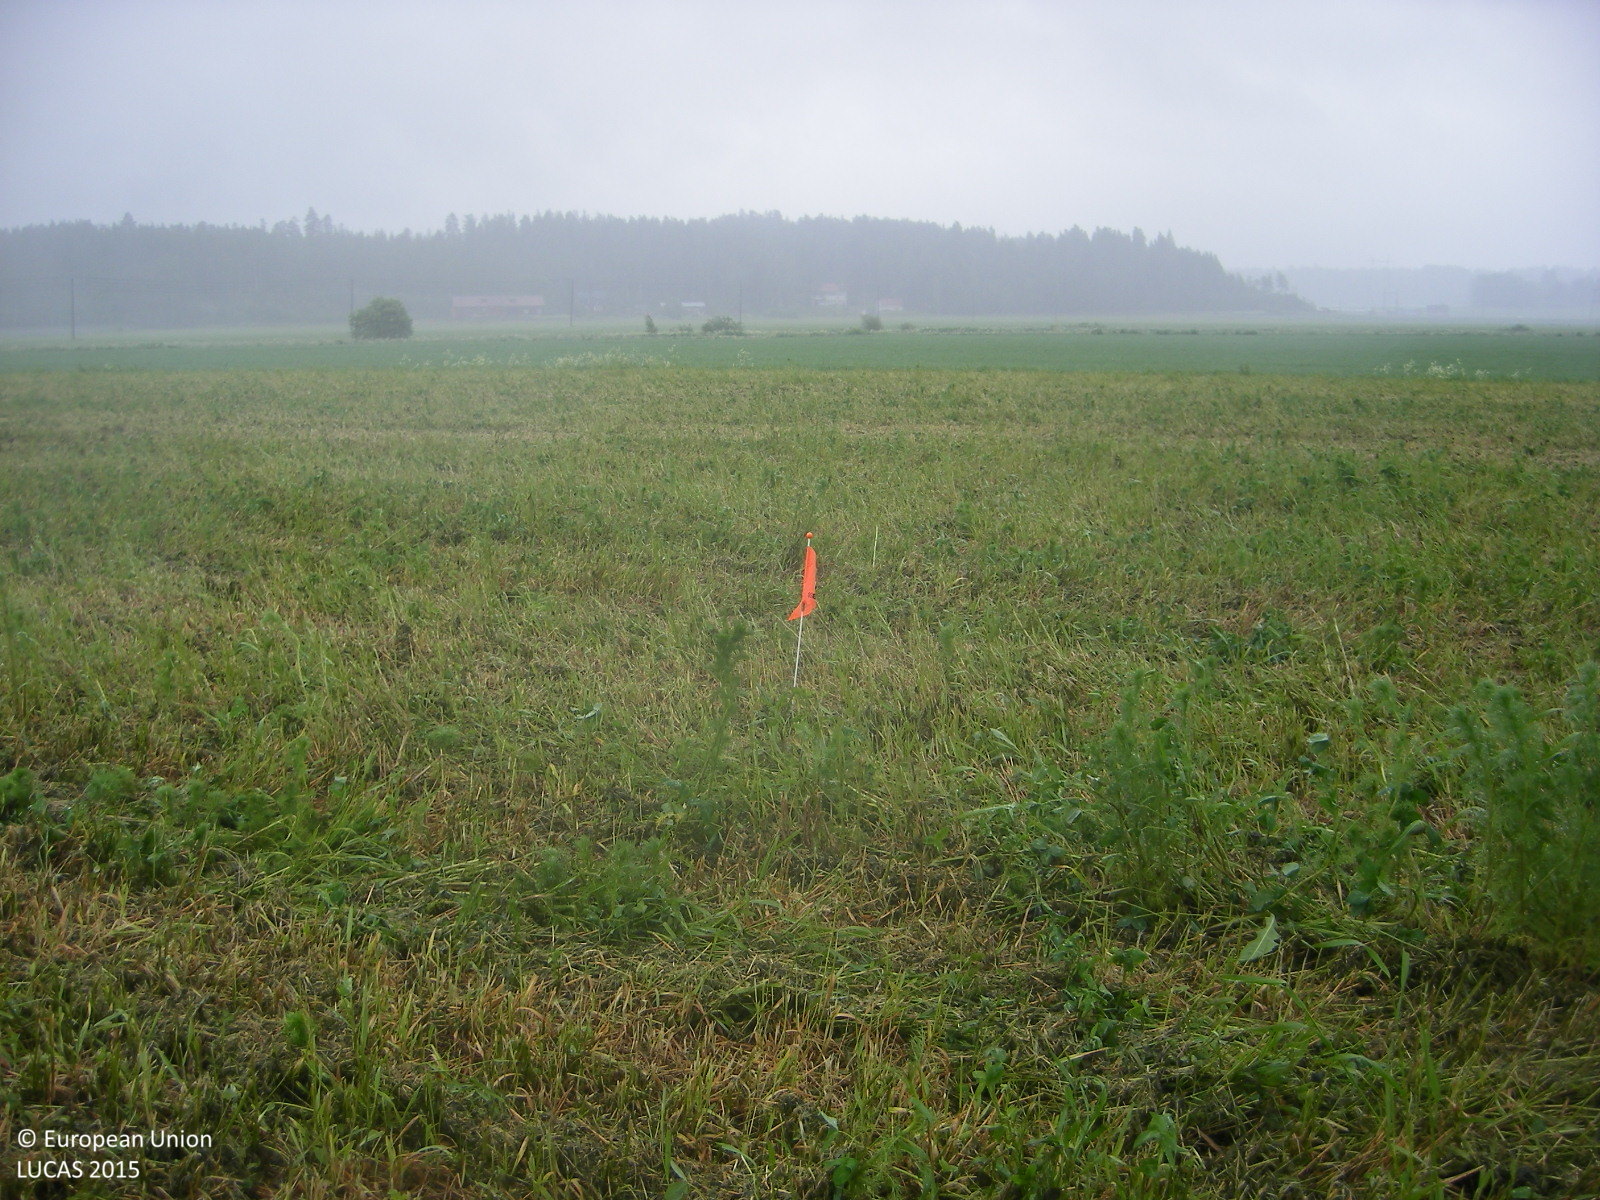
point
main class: Cropland
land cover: Other leguminous and mixtures for fodder
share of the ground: > 75 %
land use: Agriculture (excluding fallow land and kitchen gardens)
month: June
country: FI
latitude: 60.1144
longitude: 24.2273
